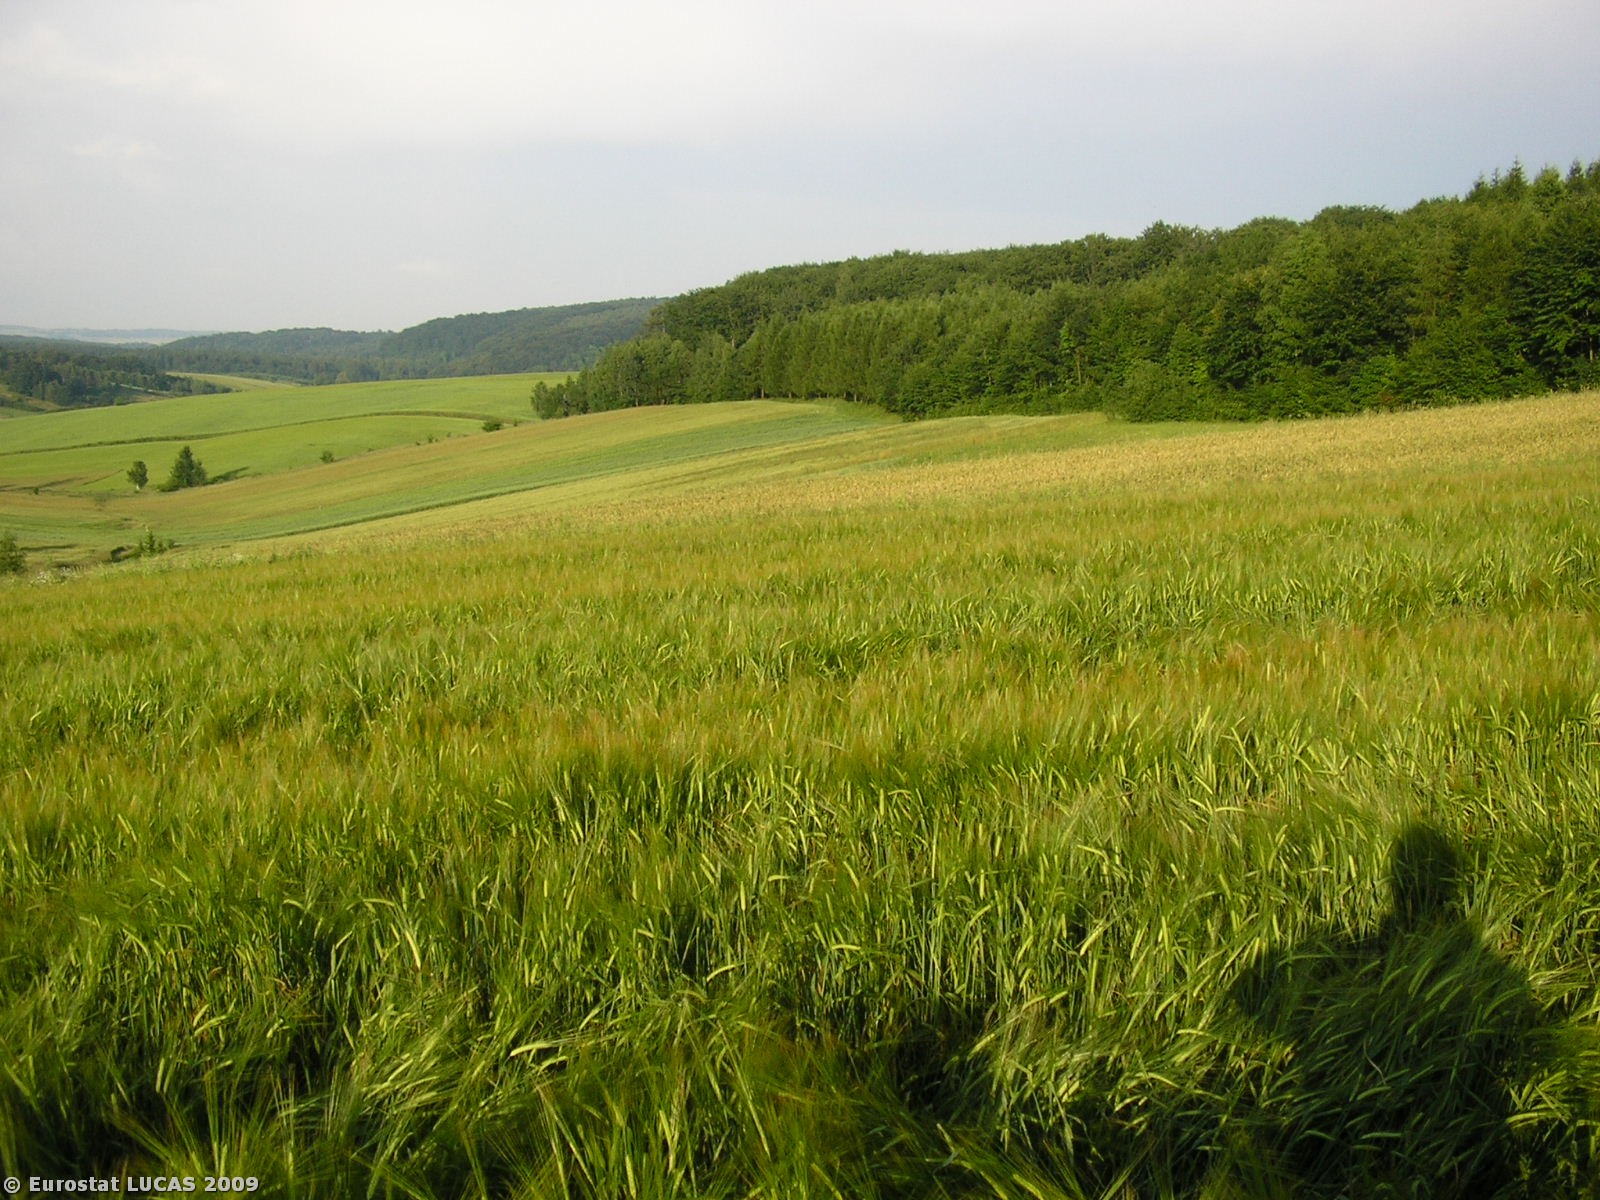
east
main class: Cropland
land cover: Barley
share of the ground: > 75 %
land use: Agriculture (excluding fallow land and kitchen gardens)
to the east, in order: Barley; Grass margins; Triticale; Grass margins; Common wheat; Grassland without tree/shrub cover; Common wheat; Grass margins; Oats; Grass margins; Oats; Grass margins; Coniferous woodland
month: June
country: PL
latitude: 50.4082
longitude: 20.0658
